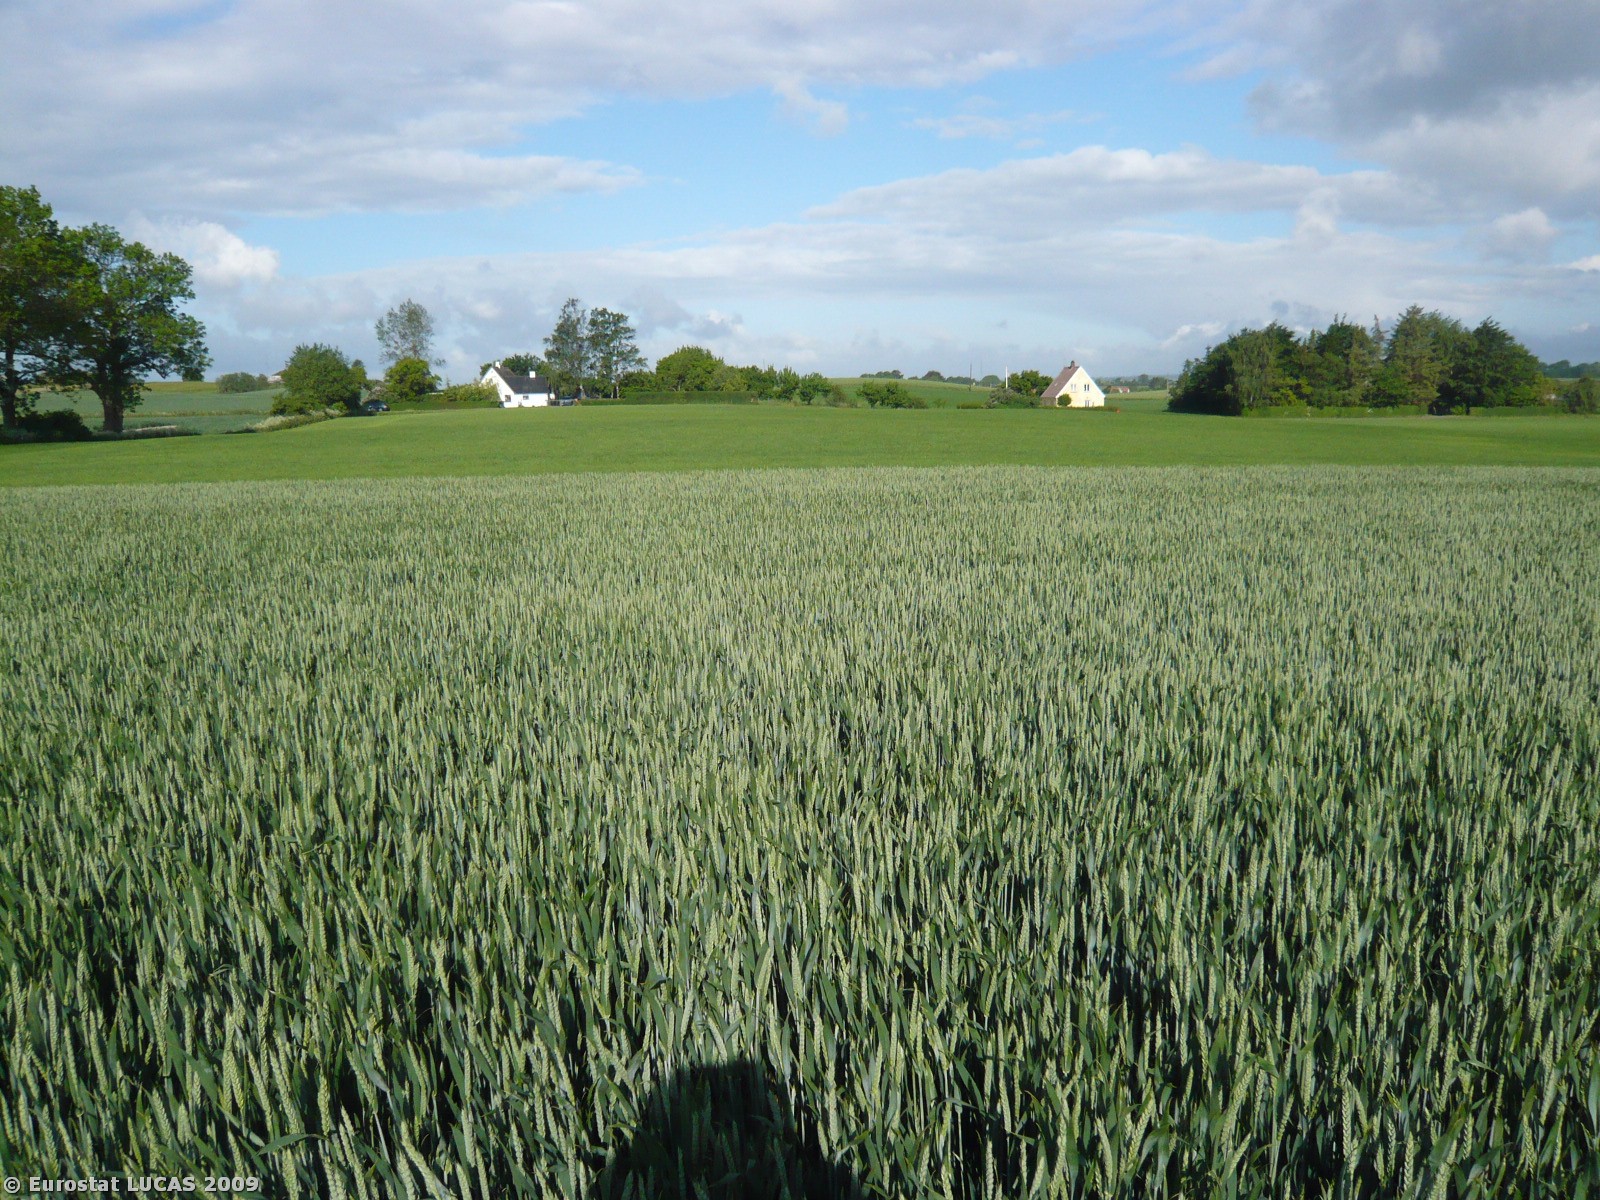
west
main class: Cropland
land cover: Common wheat
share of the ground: > 75 %
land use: Agriculture (excluding fallow land and kitchen gardens)
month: June
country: DK
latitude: 54.9451
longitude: 12.2623
